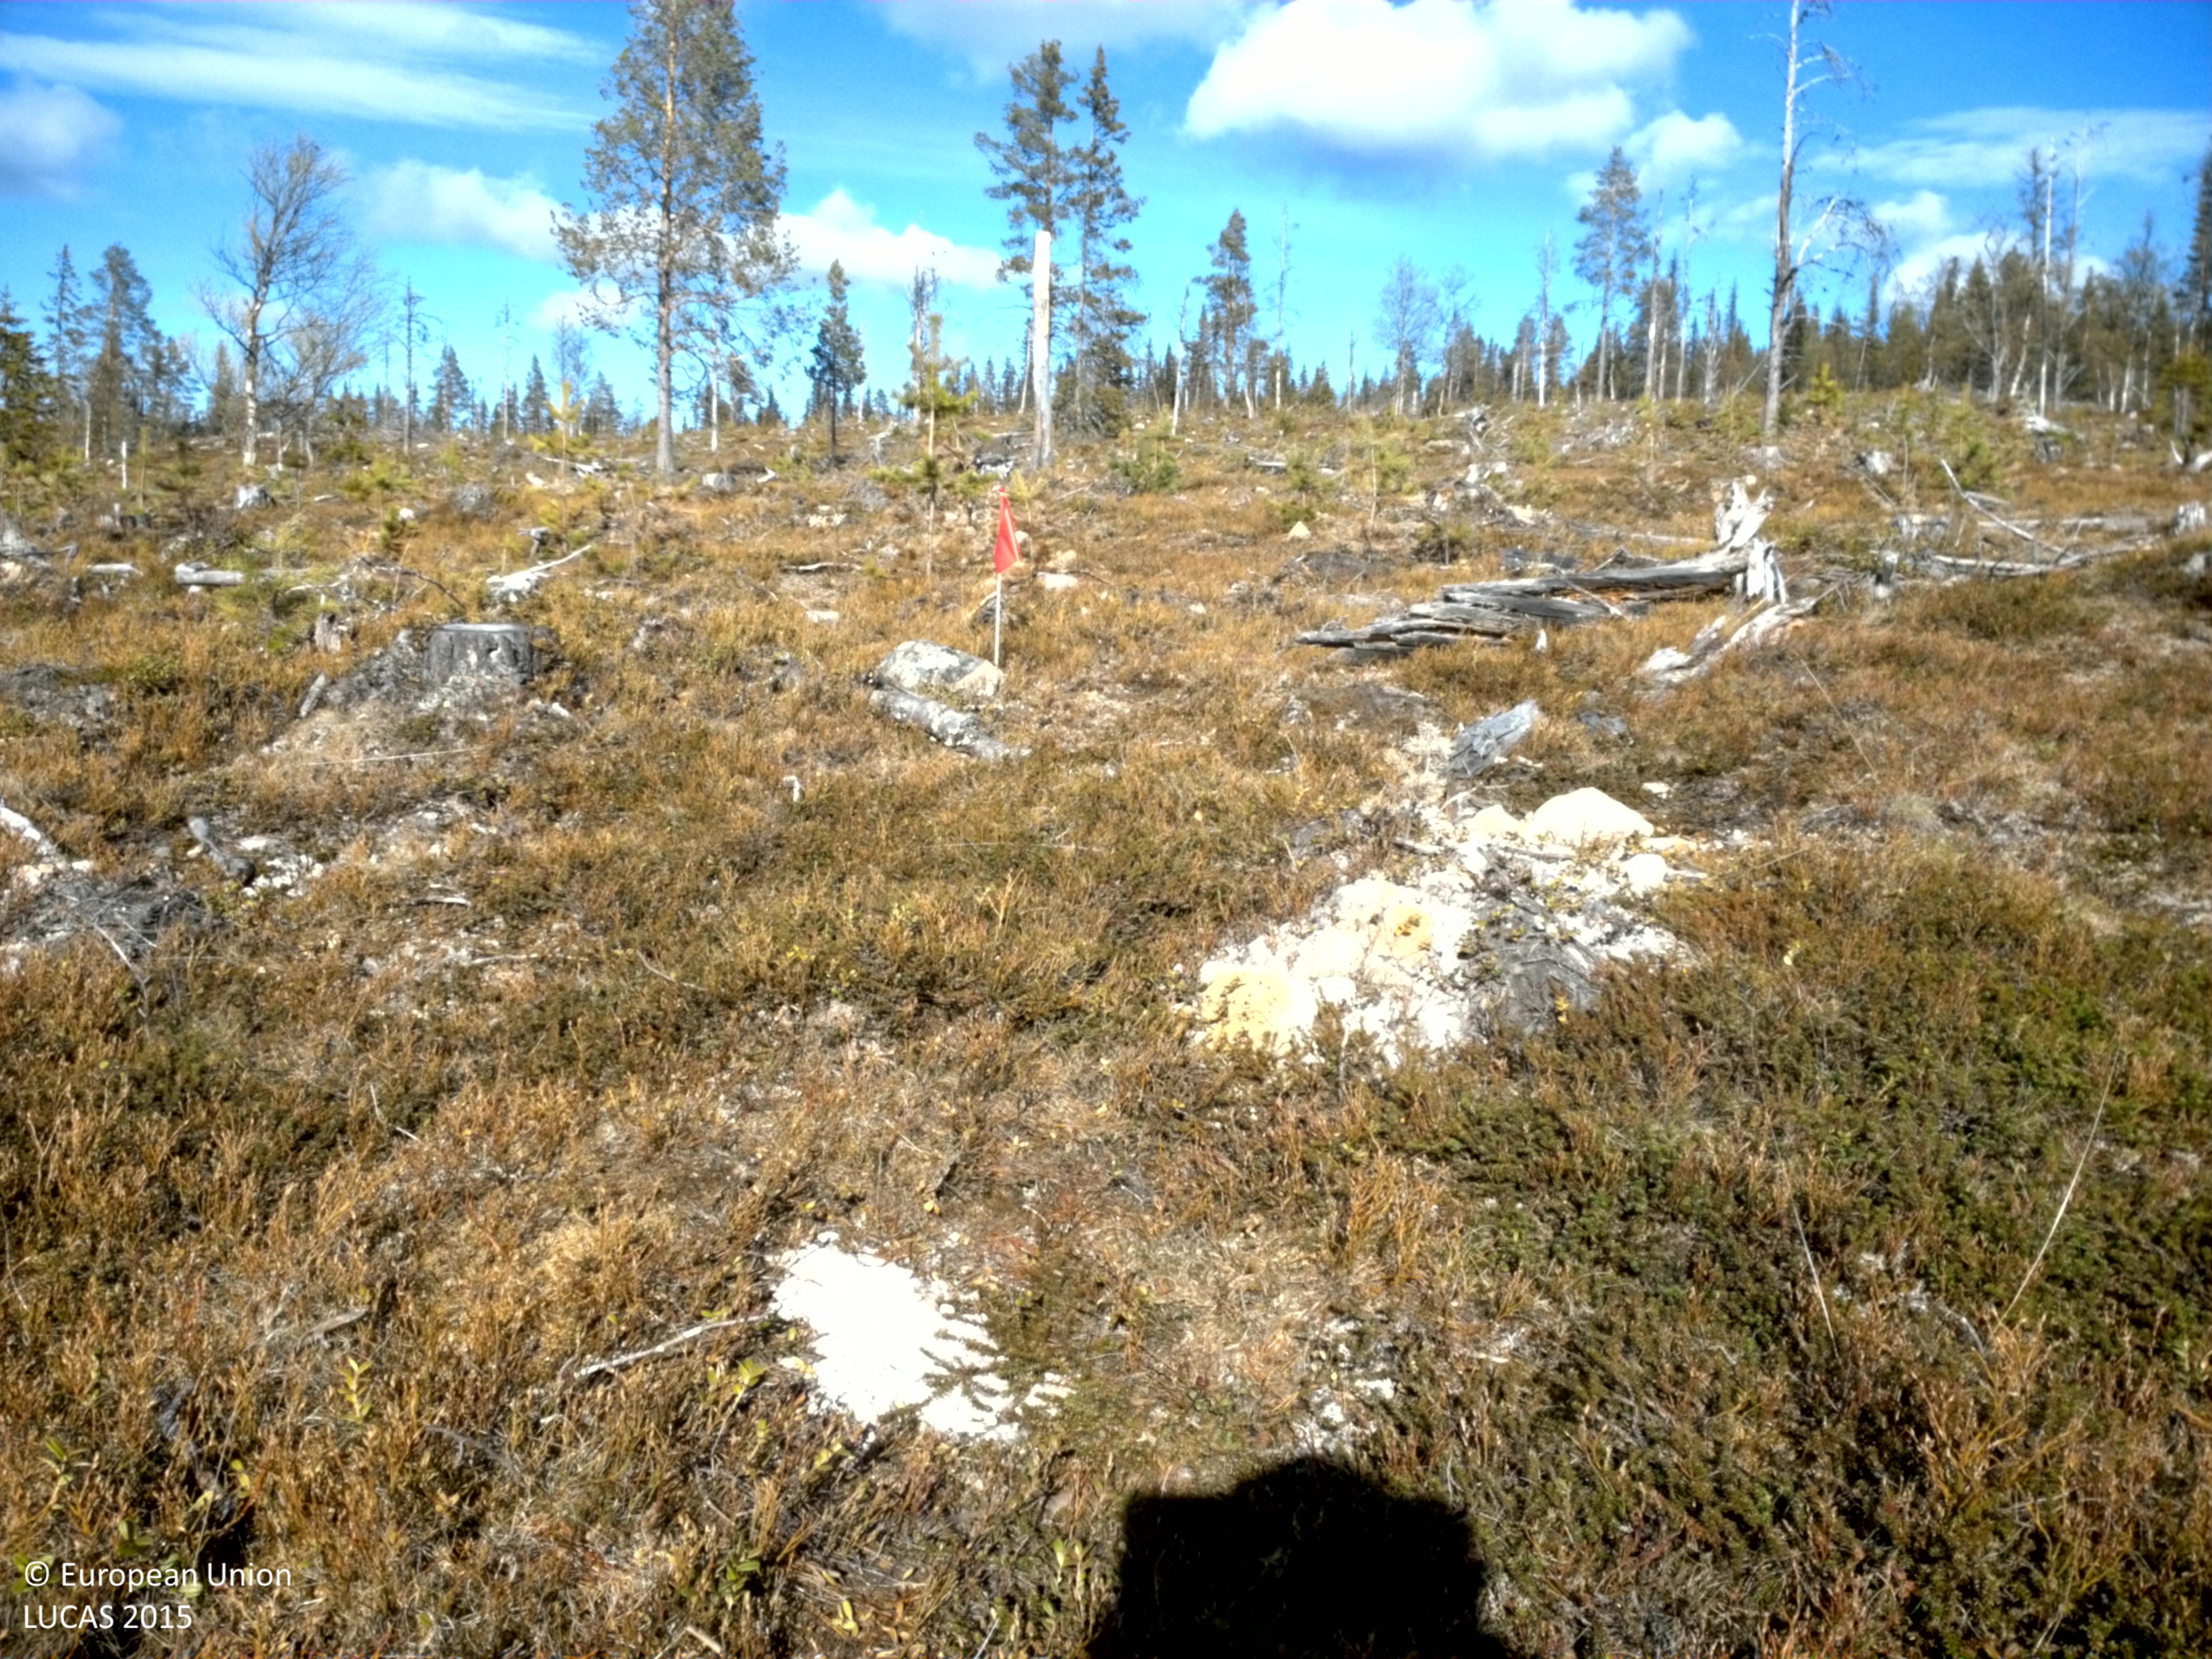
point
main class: Shrubland
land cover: Shrubland with sparse tree cover
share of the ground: > 75 %
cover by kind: shrubs 90 %, coniferous forest trees 5 %, consolidated bare surface 5 %
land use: Forestry
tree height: < 5 m
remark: Clear cut
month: June
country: SE
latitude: 66.3821
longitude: 18.2956
